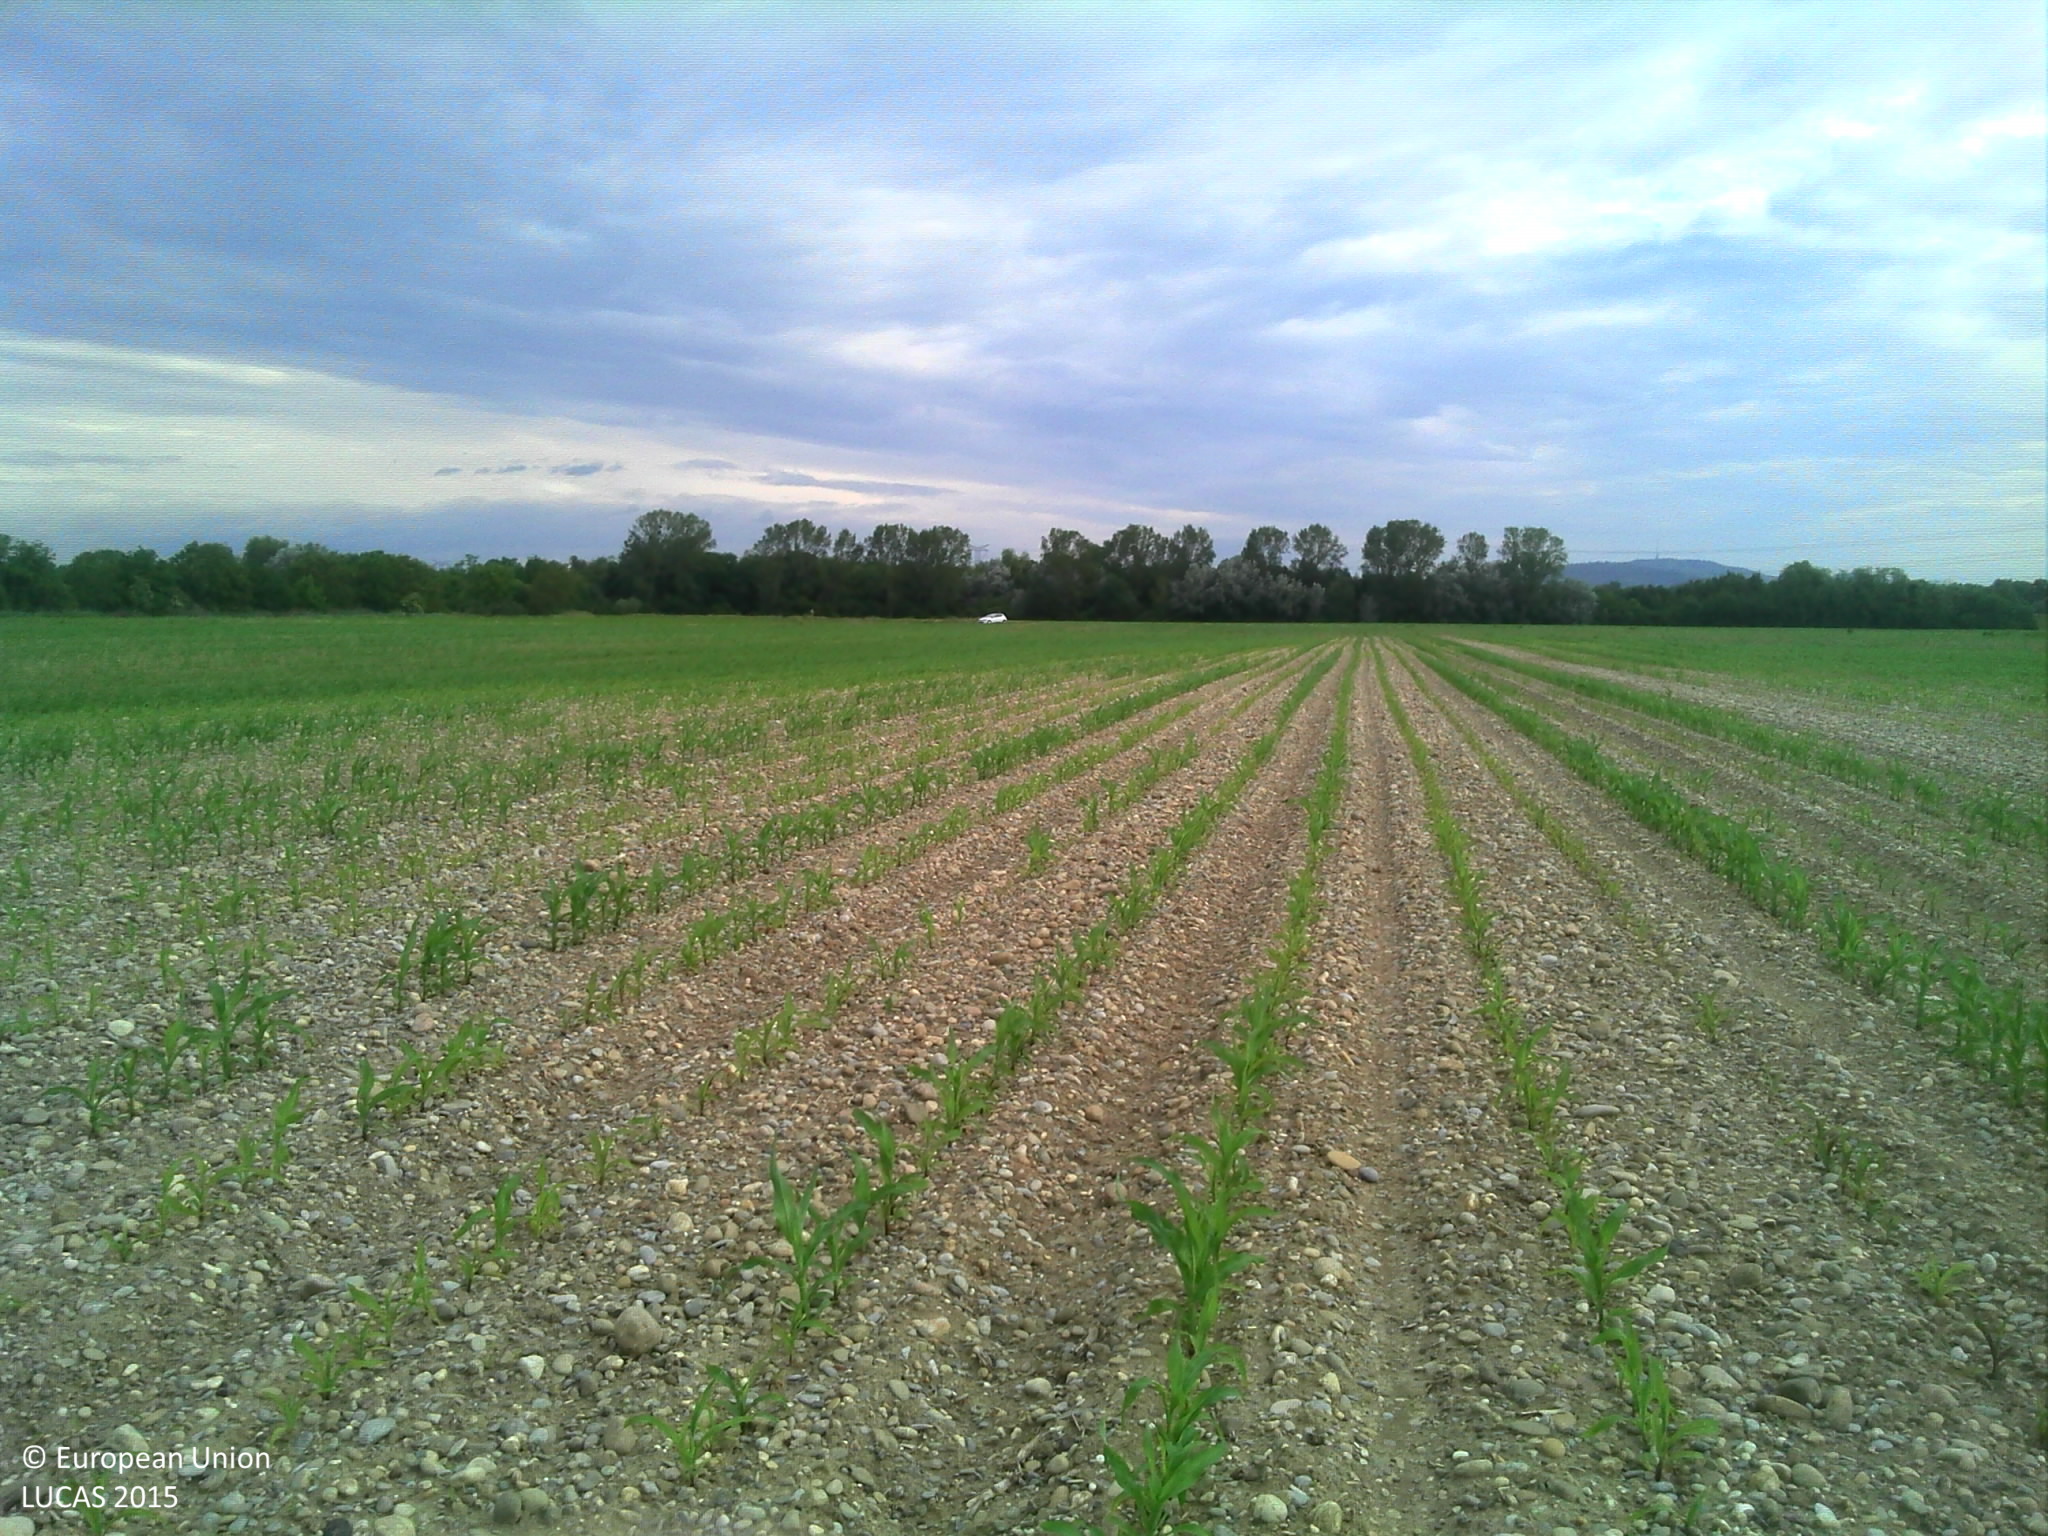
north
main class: Cropland
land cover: Maize
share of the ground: < 10 %
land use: Agriculture (excluding fallow land and kitchen gardens)
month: June
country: FR
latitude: 47.9815
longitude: 7.6030
